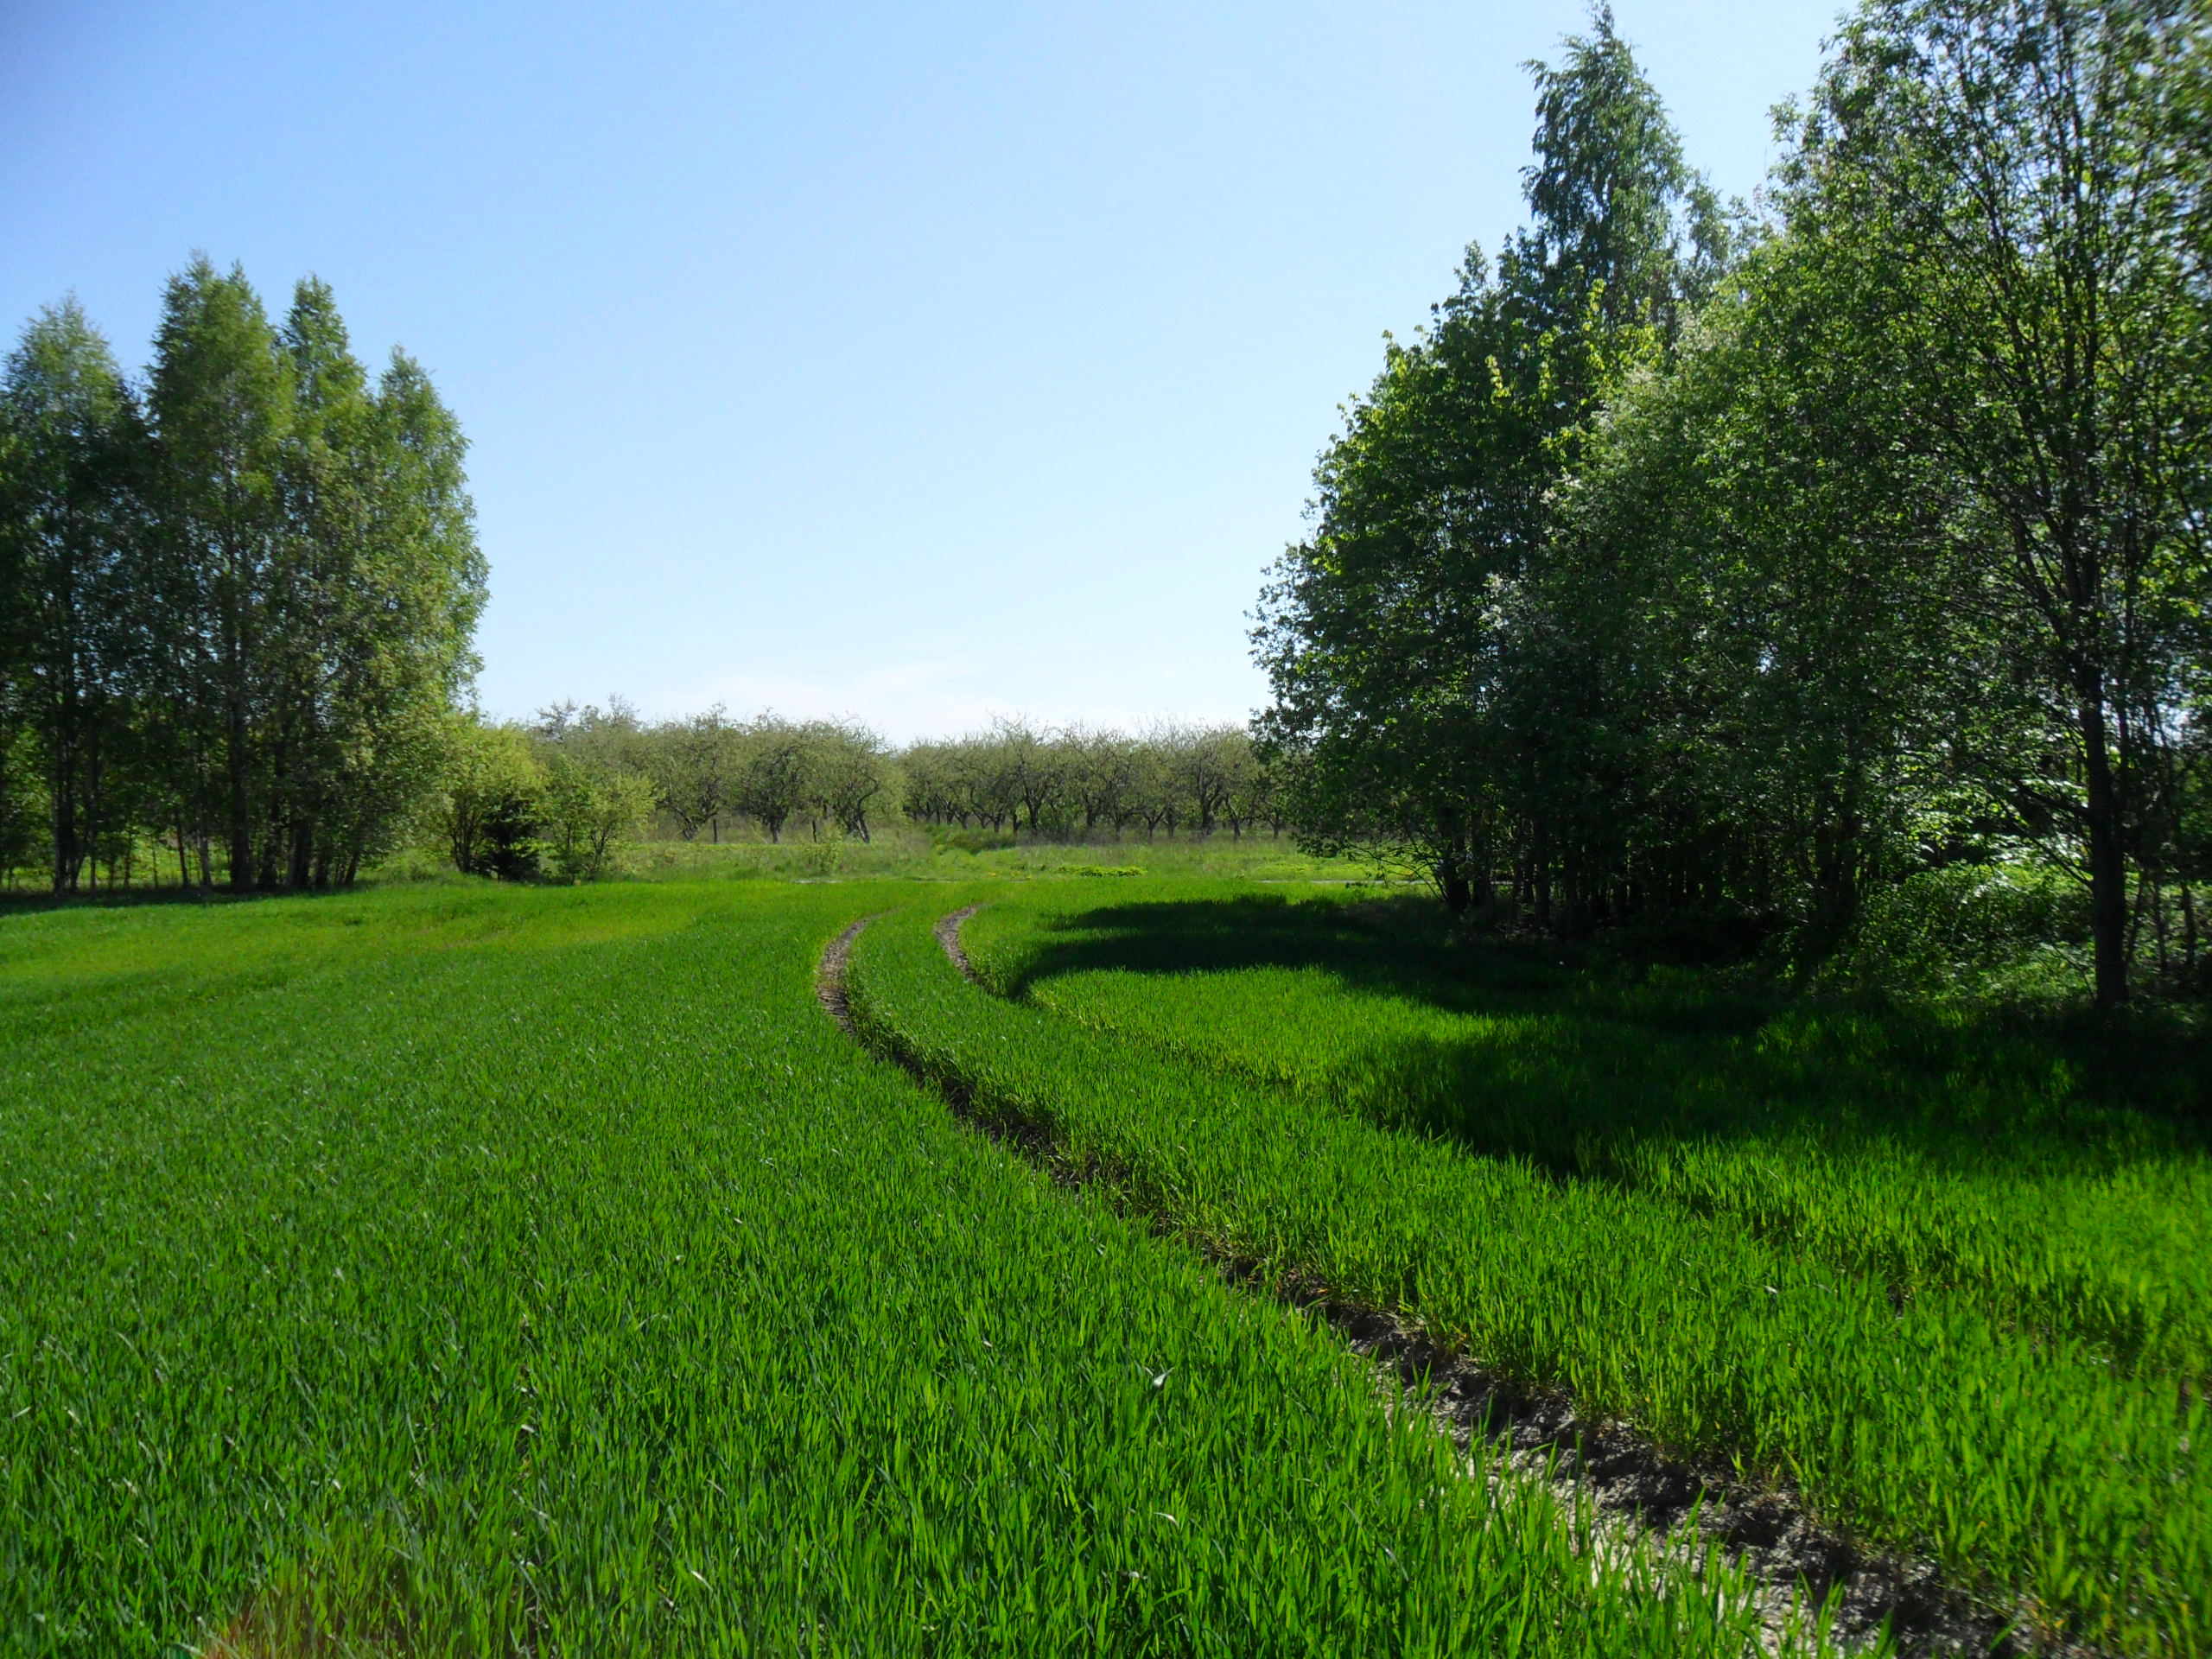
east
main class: Cropland
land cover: Barley
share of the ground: > 75 %
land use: Agriculture (excluding fallow land and kitchen gardens)
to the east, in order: Barley; Grass margins; Paved roads, cycling and walking lanes; Grassland without tree/shrub cover; Fences; Apple fruit; Other fruit trees and berries; Apple fruit
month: May
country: LV
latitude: 57.2293
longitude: 22.5277
